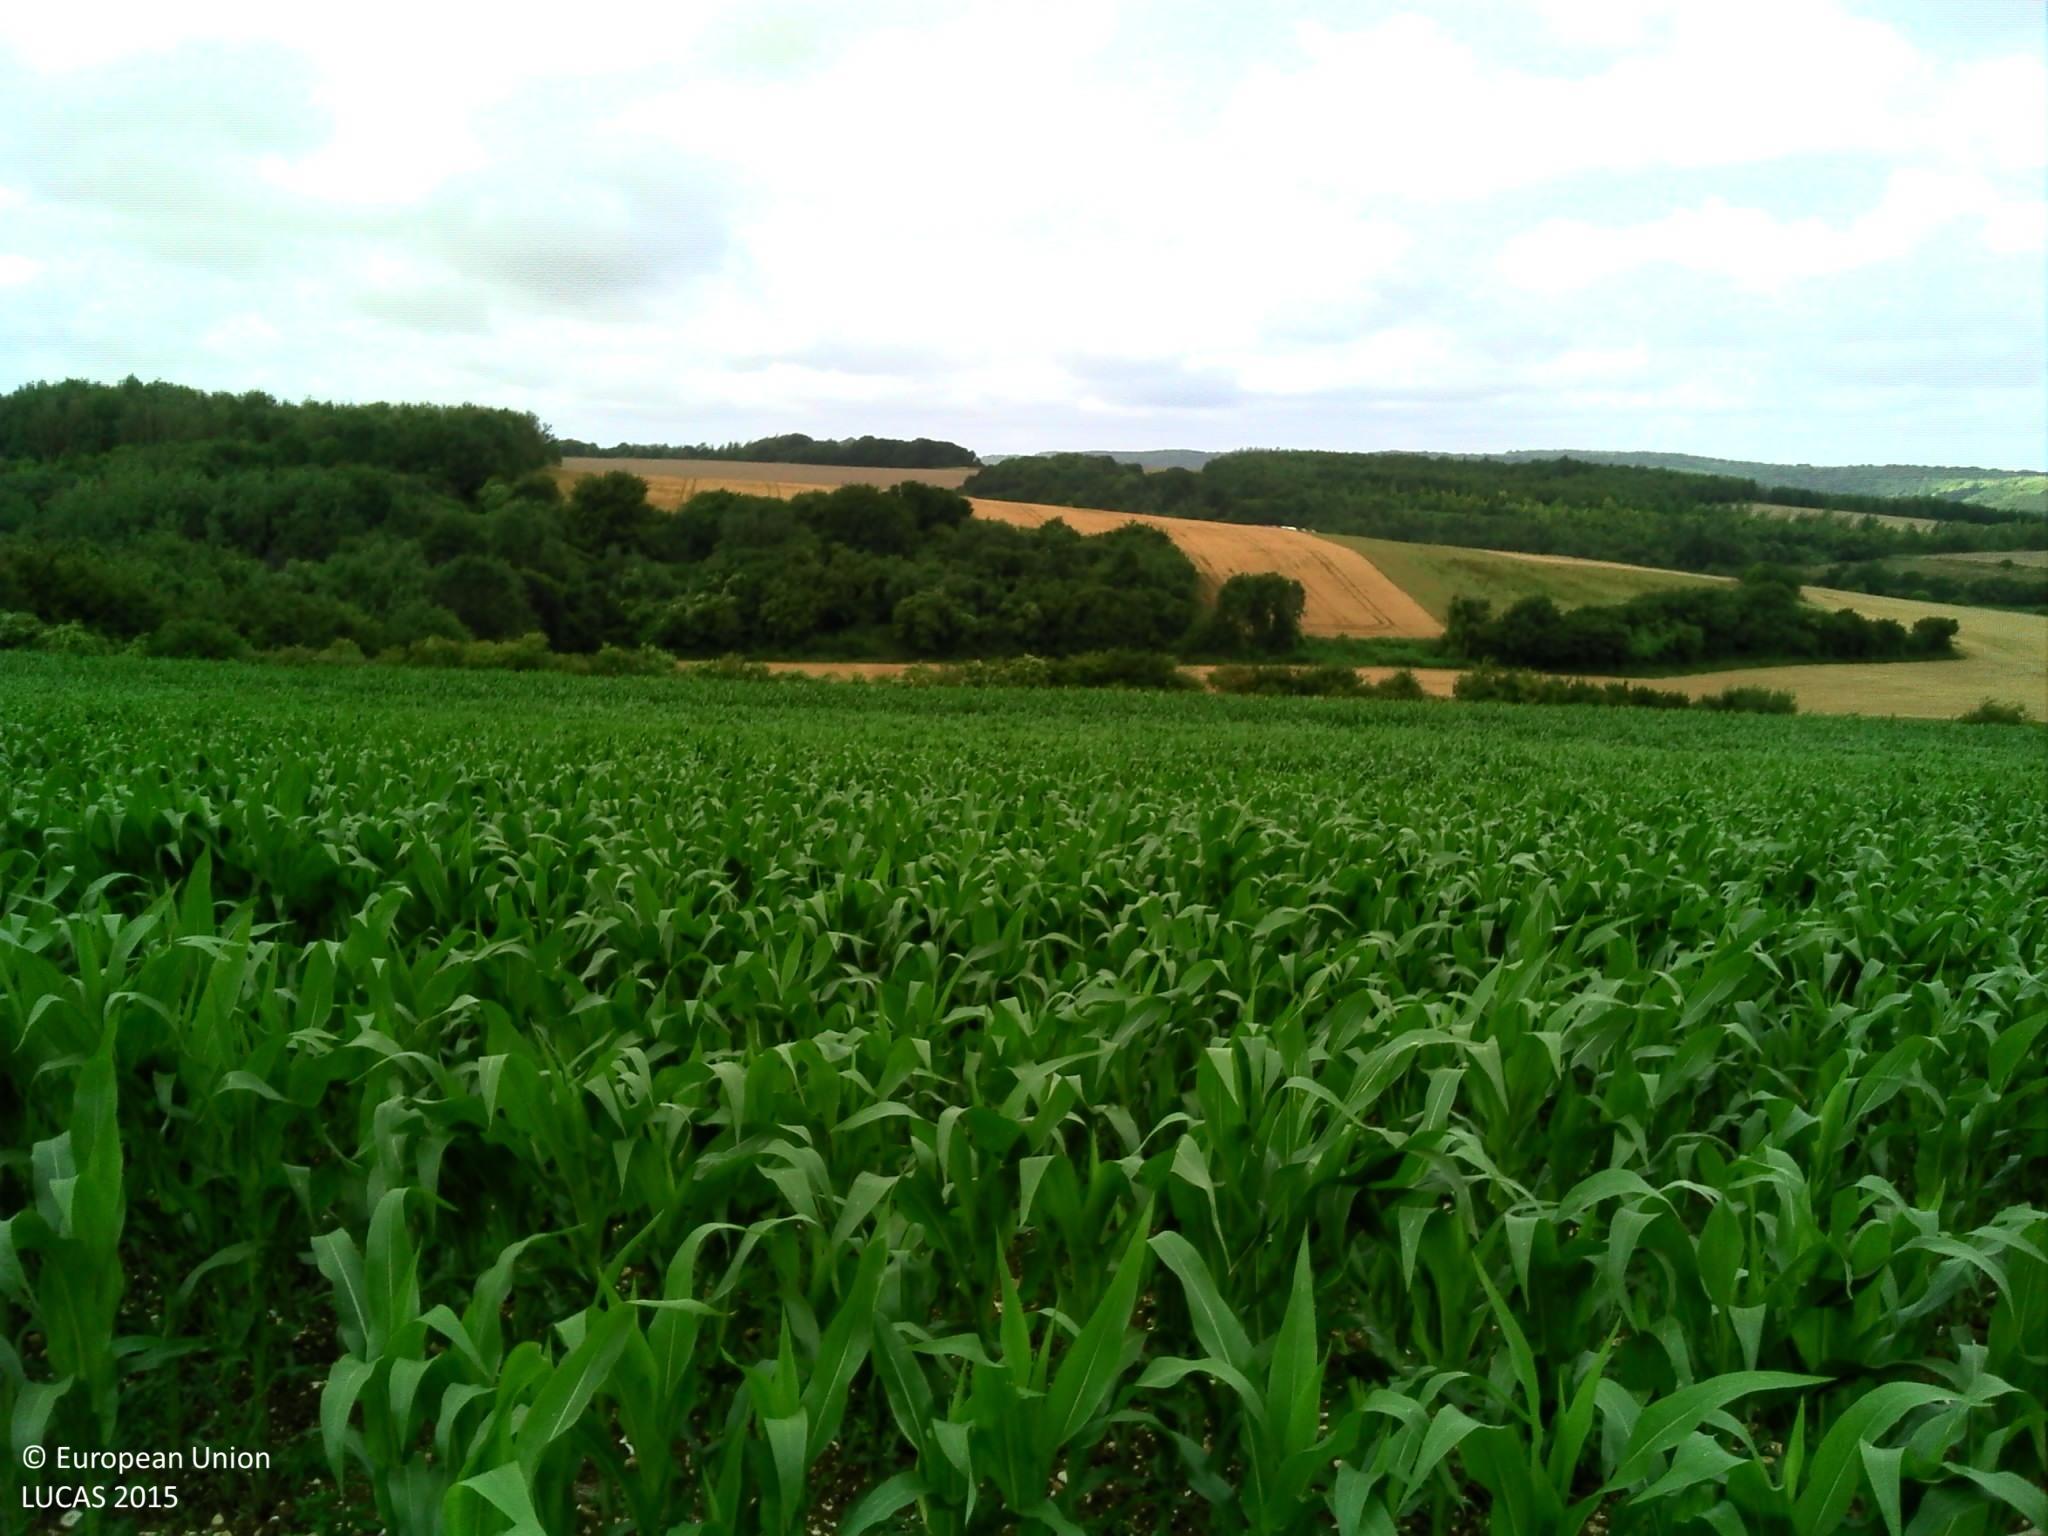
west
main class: Cropland
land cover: Maize
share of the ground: > 75 %
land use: Agriculture (excluding fallow land and kitchen gardens)
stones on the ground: 25 - 50 %
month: July
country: FR
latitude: 50.7921
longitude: 2.0544
